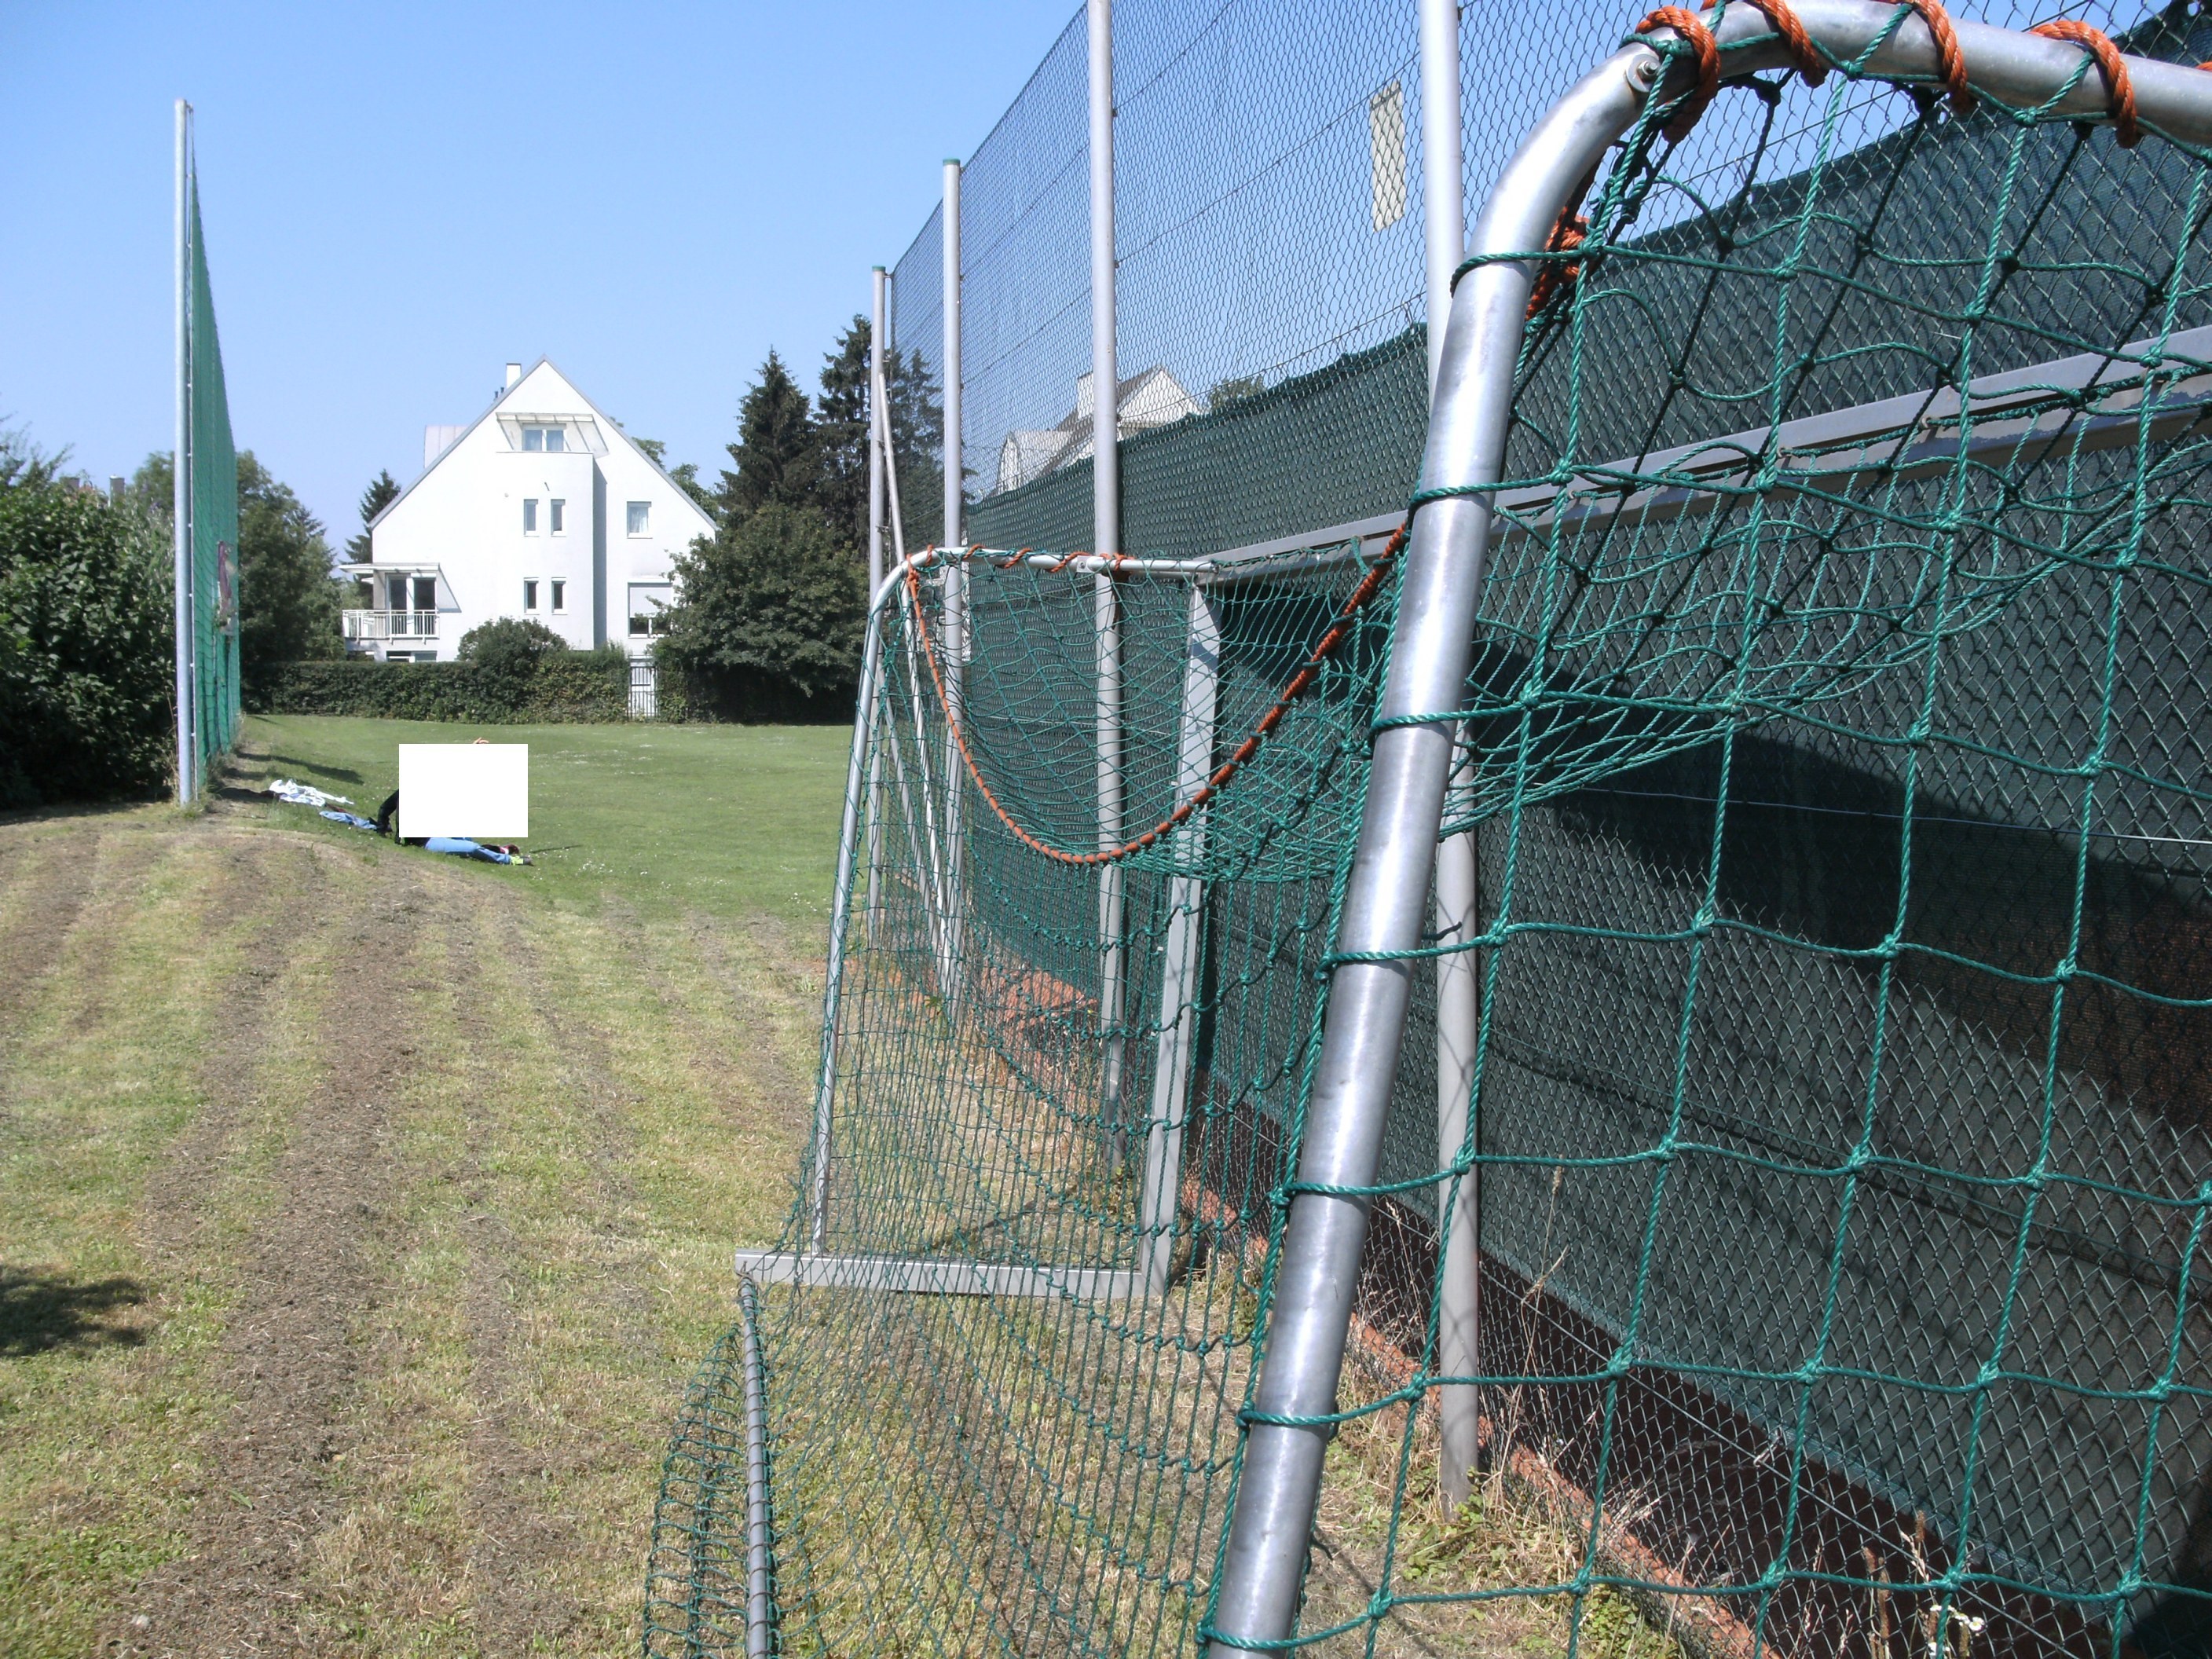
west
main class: Grassland
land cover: Grassland without tree/shrub cover
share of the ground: > 75 %
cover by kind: herbaceous plants 100 %
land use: Sport
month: July
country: AT
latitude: 48.2839
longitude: 14.2991
